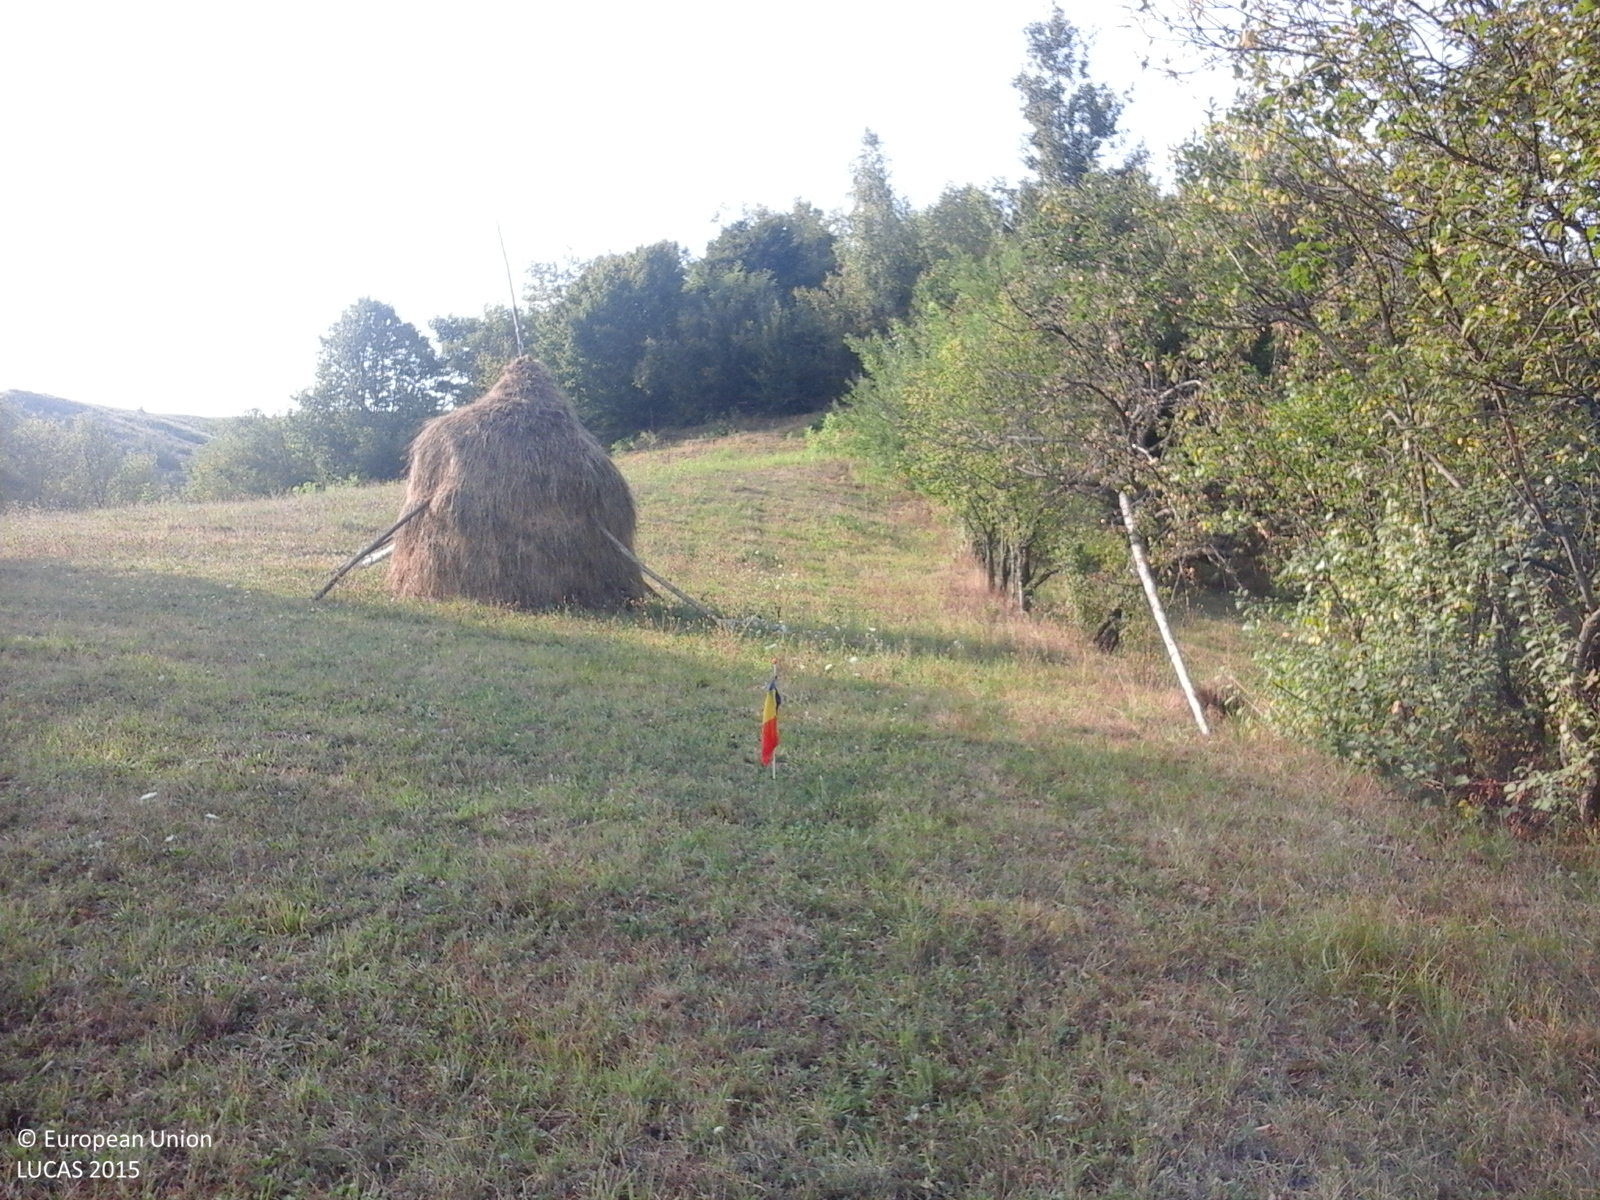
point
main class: Grassland
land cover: Grassland without tree/shrub cover
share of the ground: > 75 %
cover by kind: herbaceous plants 100 %
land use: Agriculture (excluding fallow land and kitchen gardens)
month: September
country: RO
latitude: 47.4990
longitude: 24.0630
